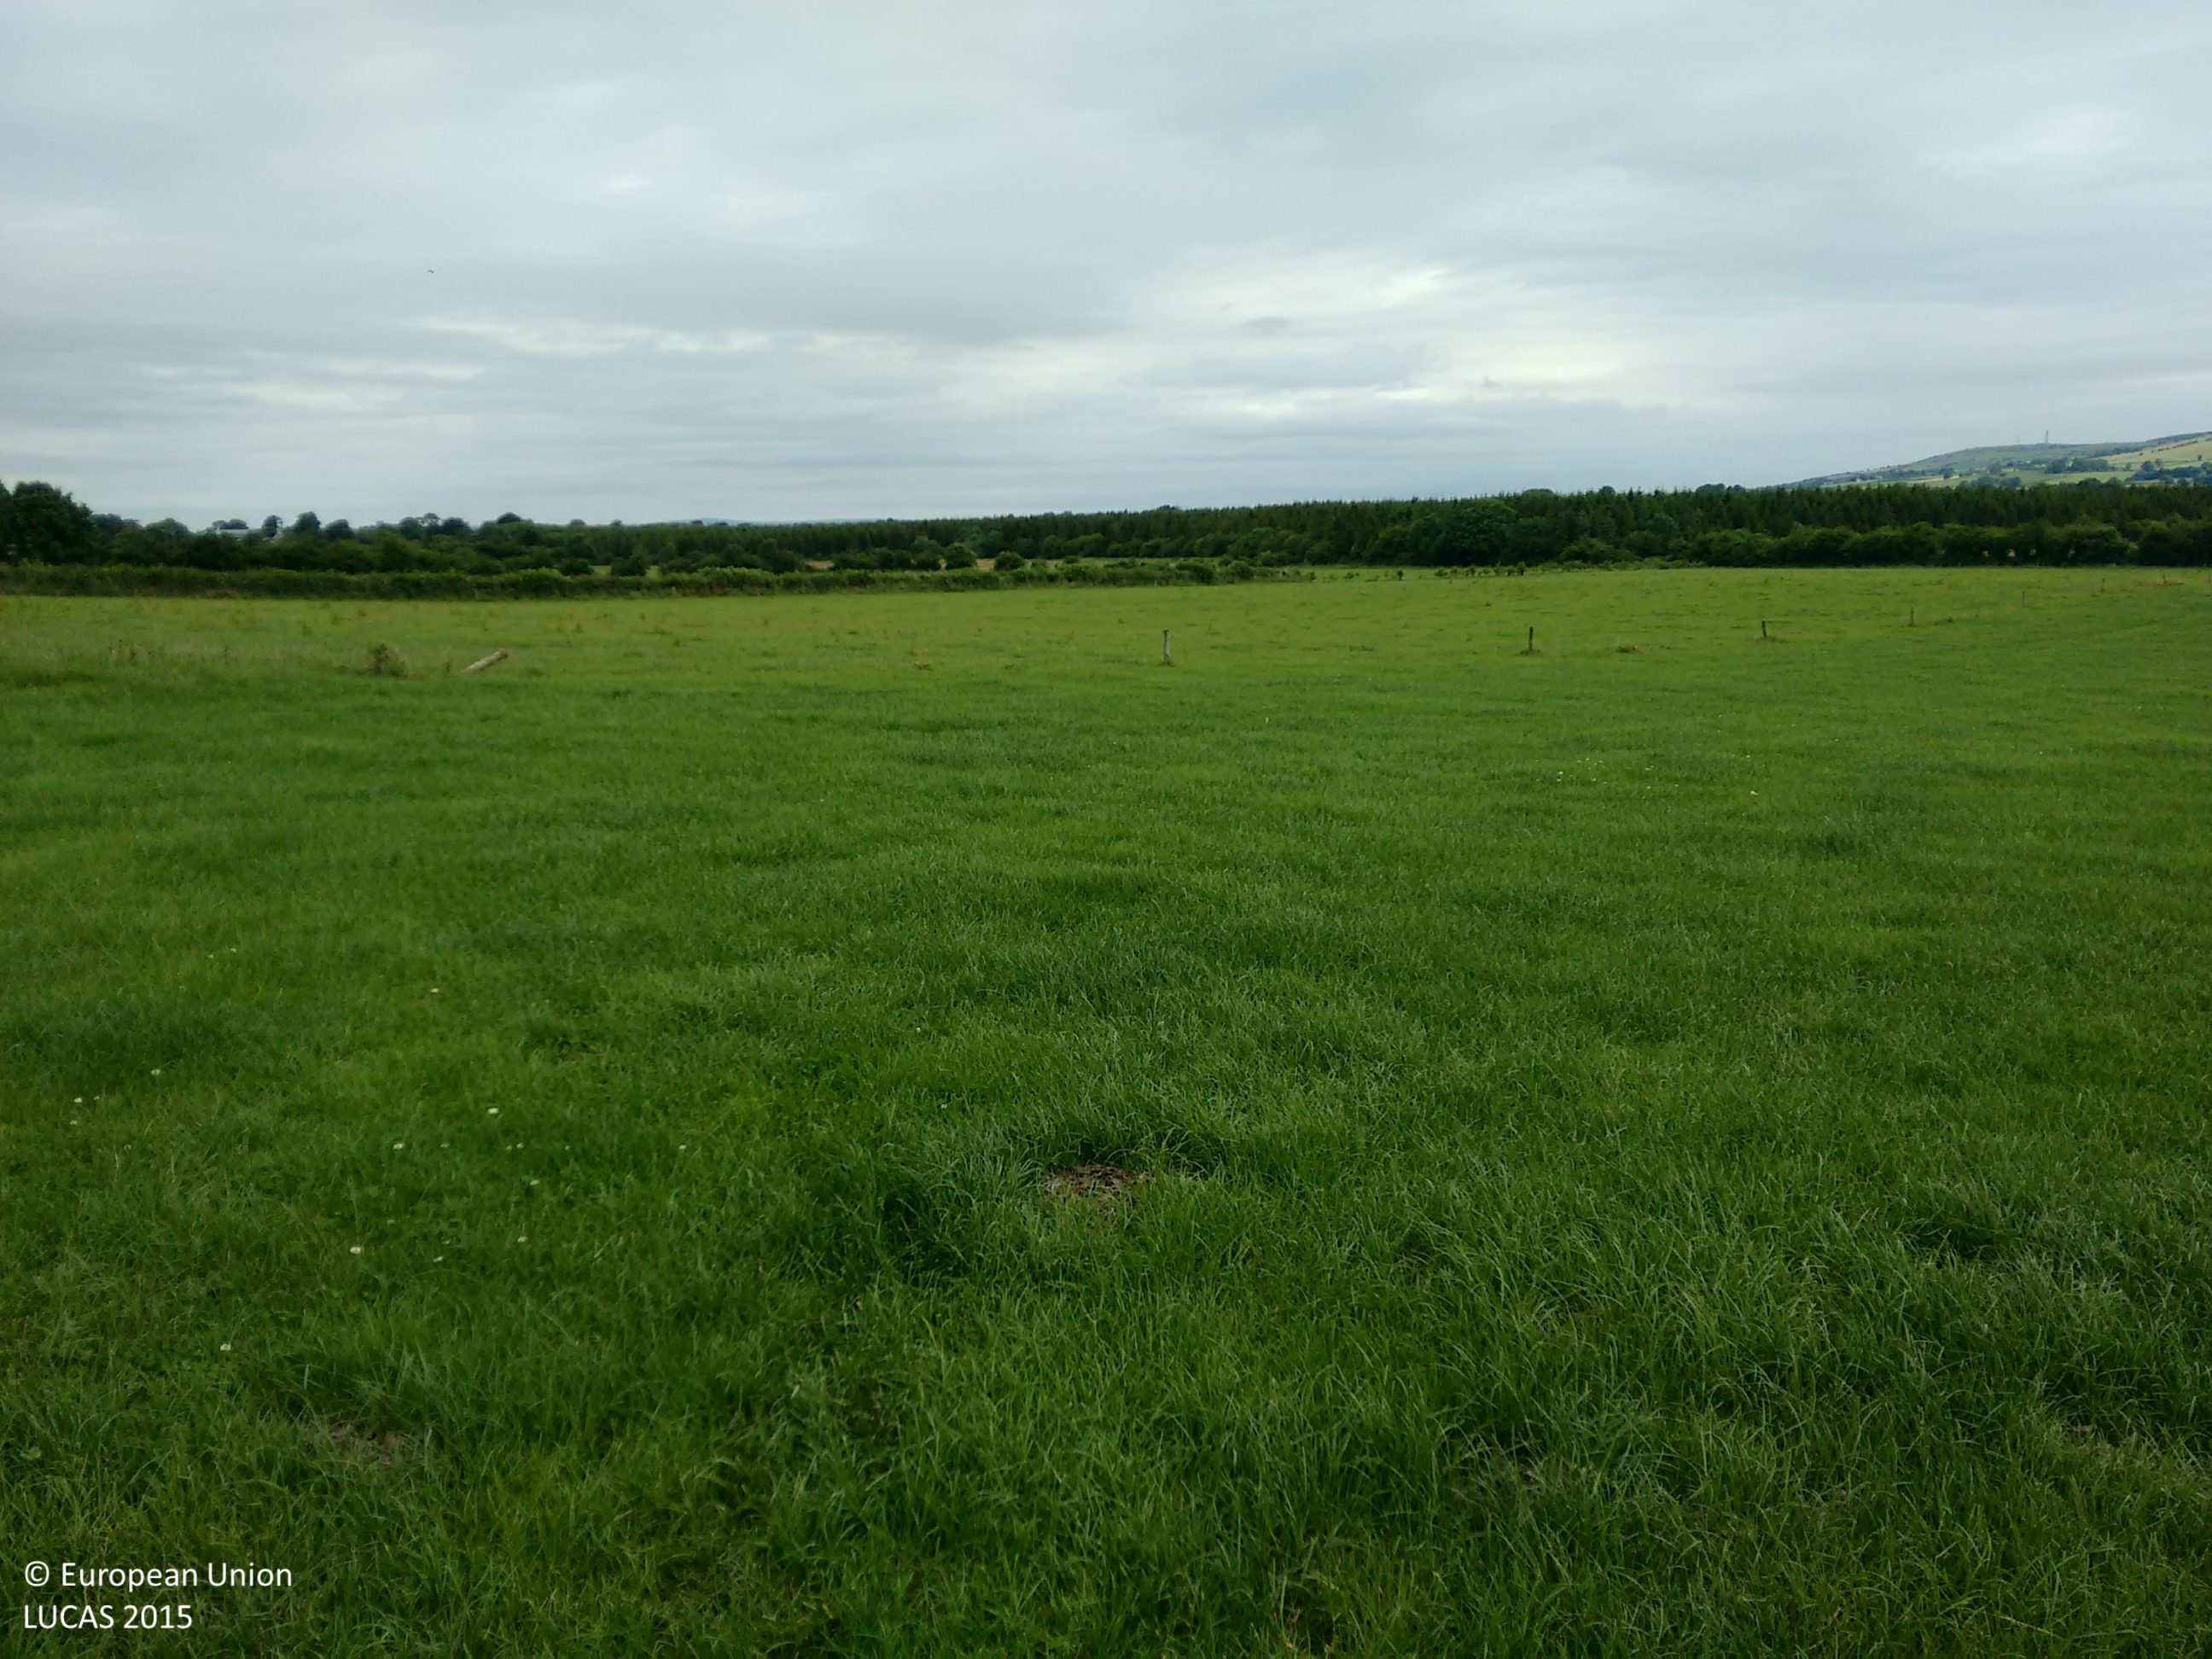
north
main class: Grassland
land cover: Grassland without tree/shrub cover
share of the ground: > 75 %
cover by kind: herbaceous plants 100 %
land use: Agriculture (excluding fallow land and kitchen gardens)
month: July
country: IE
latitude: 52.7127
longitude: -7.5535
